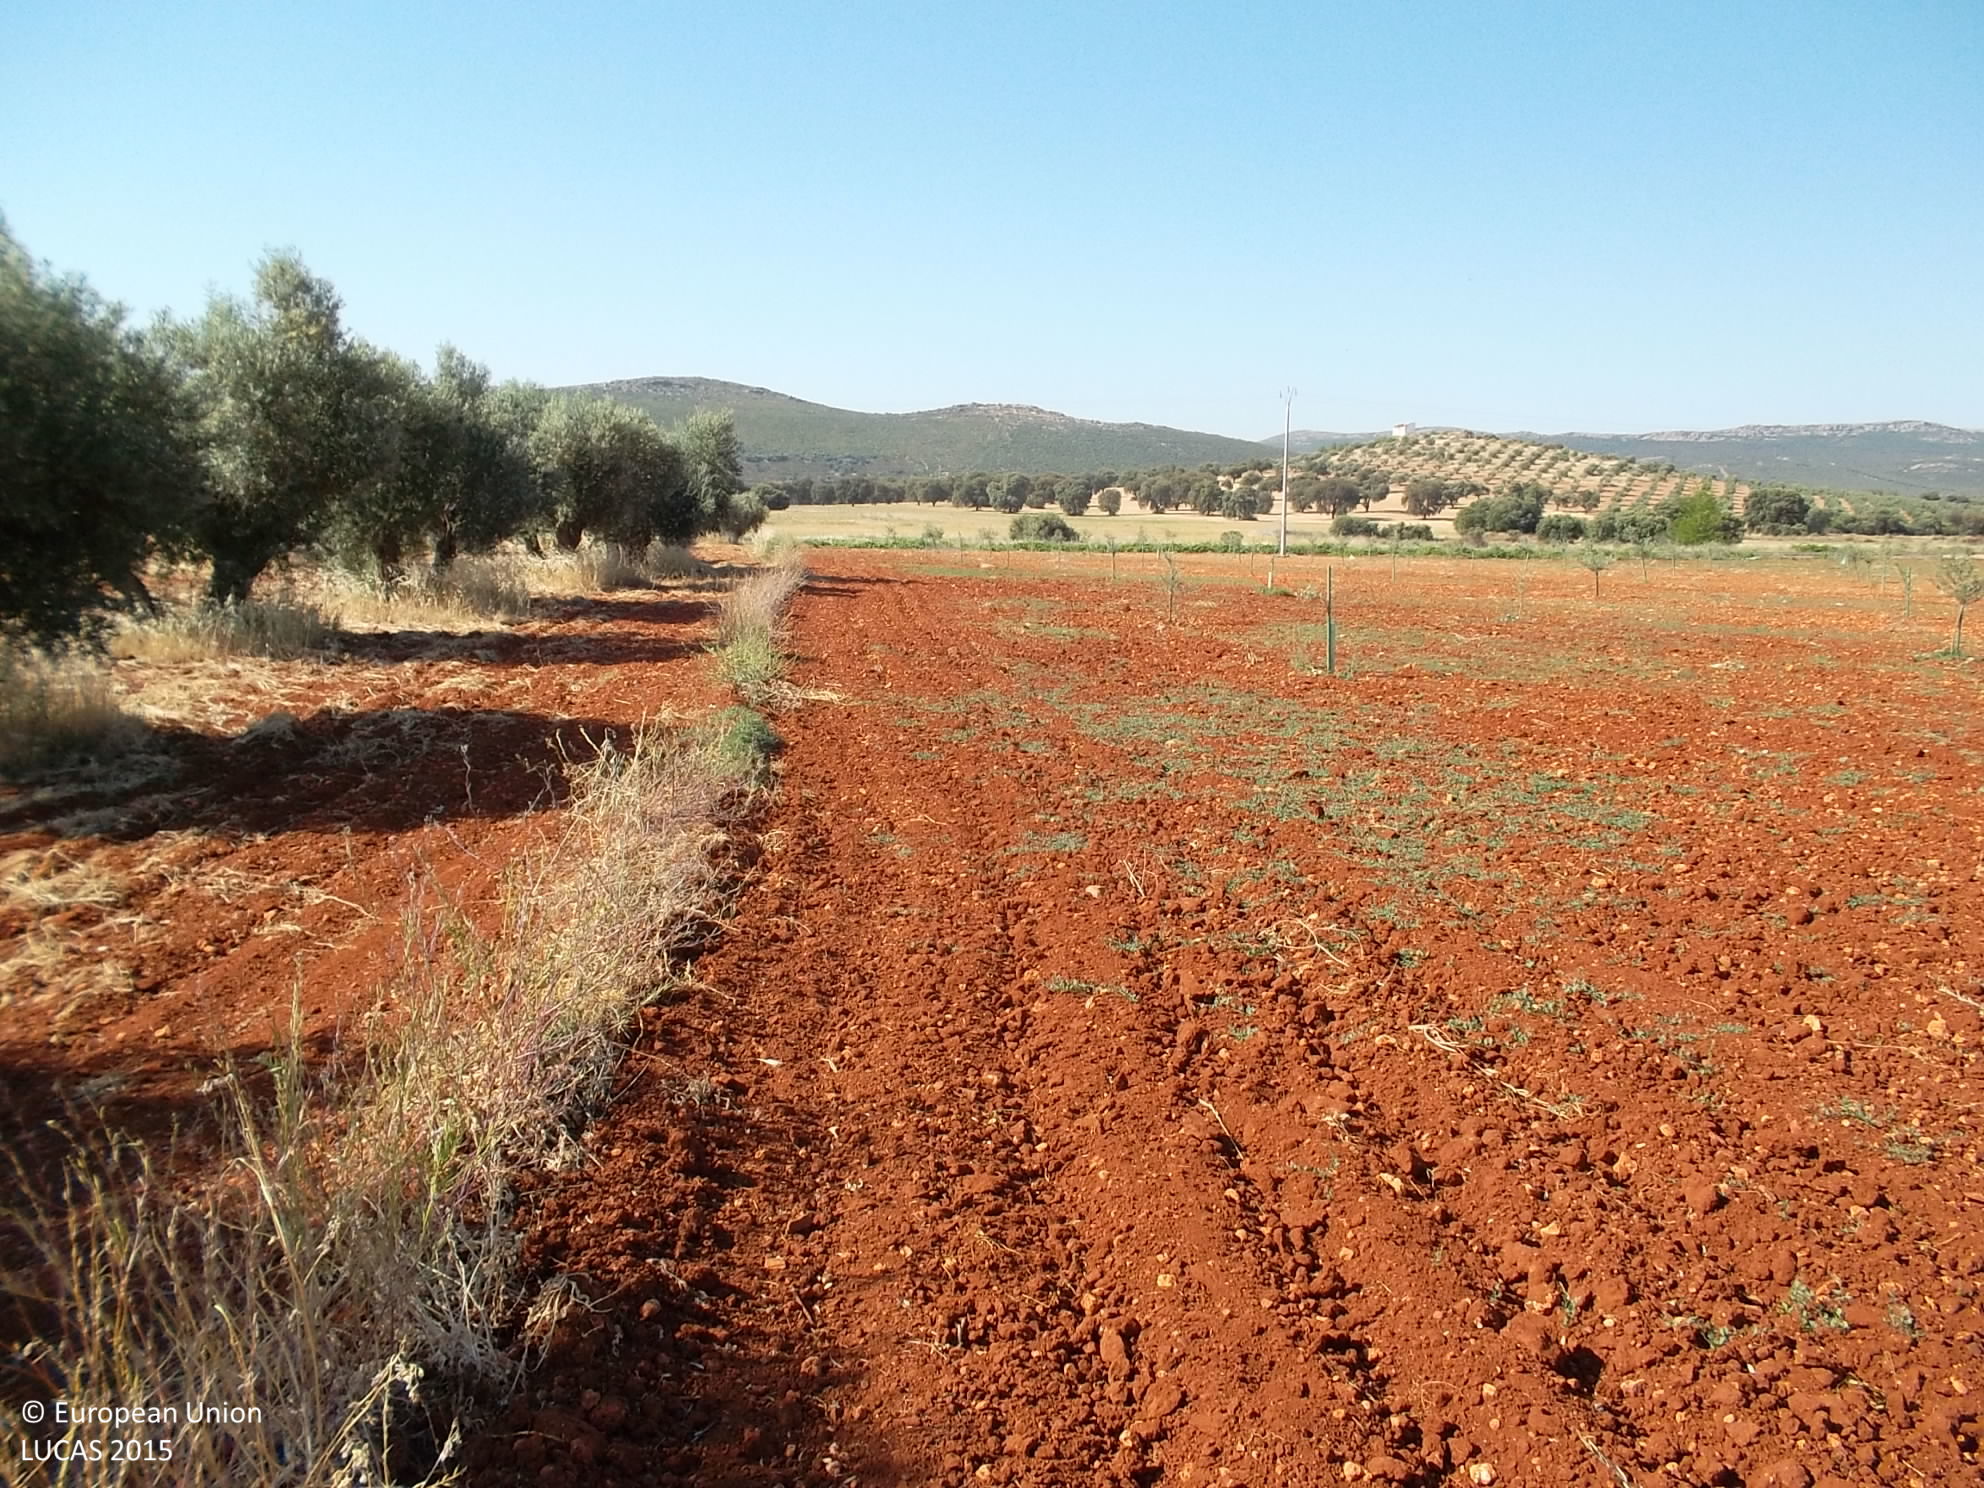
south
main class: Cropland
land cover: Olive groves
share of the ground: 10 - 25 %
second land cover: Other bare soil
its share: > 75 %
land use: Agriculture (excluding fallow land and kitchen gardens)
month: June
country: ES
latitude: 38.7416
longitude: -4.0196
